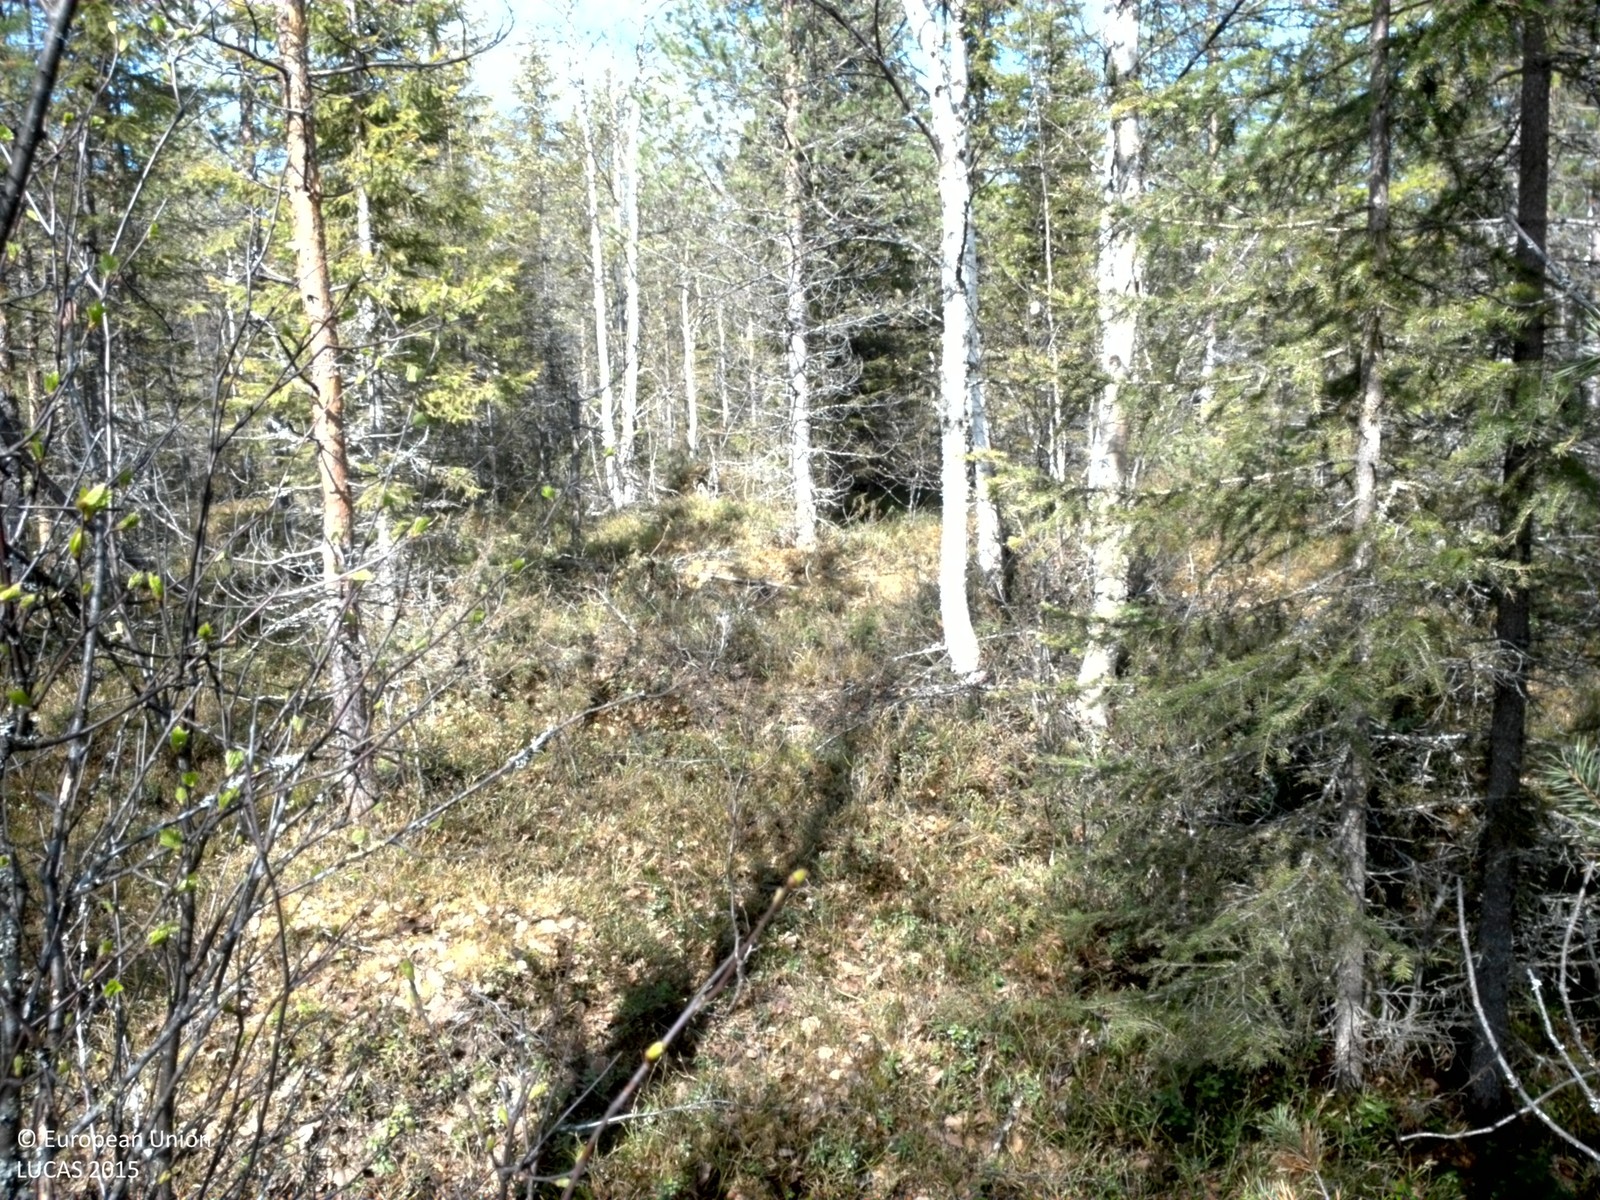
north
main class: Woodland
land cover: Pine dominated coniferous woodland
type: boreal forest
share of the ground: 50 - 75 %
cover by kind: coniferous forest trees 55 %, shrubs 35 %, broadleaved forest trees 10 %
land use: Forestry
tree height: < 5 m
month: May
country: SE
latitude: 66.1552
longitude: 23.2642
